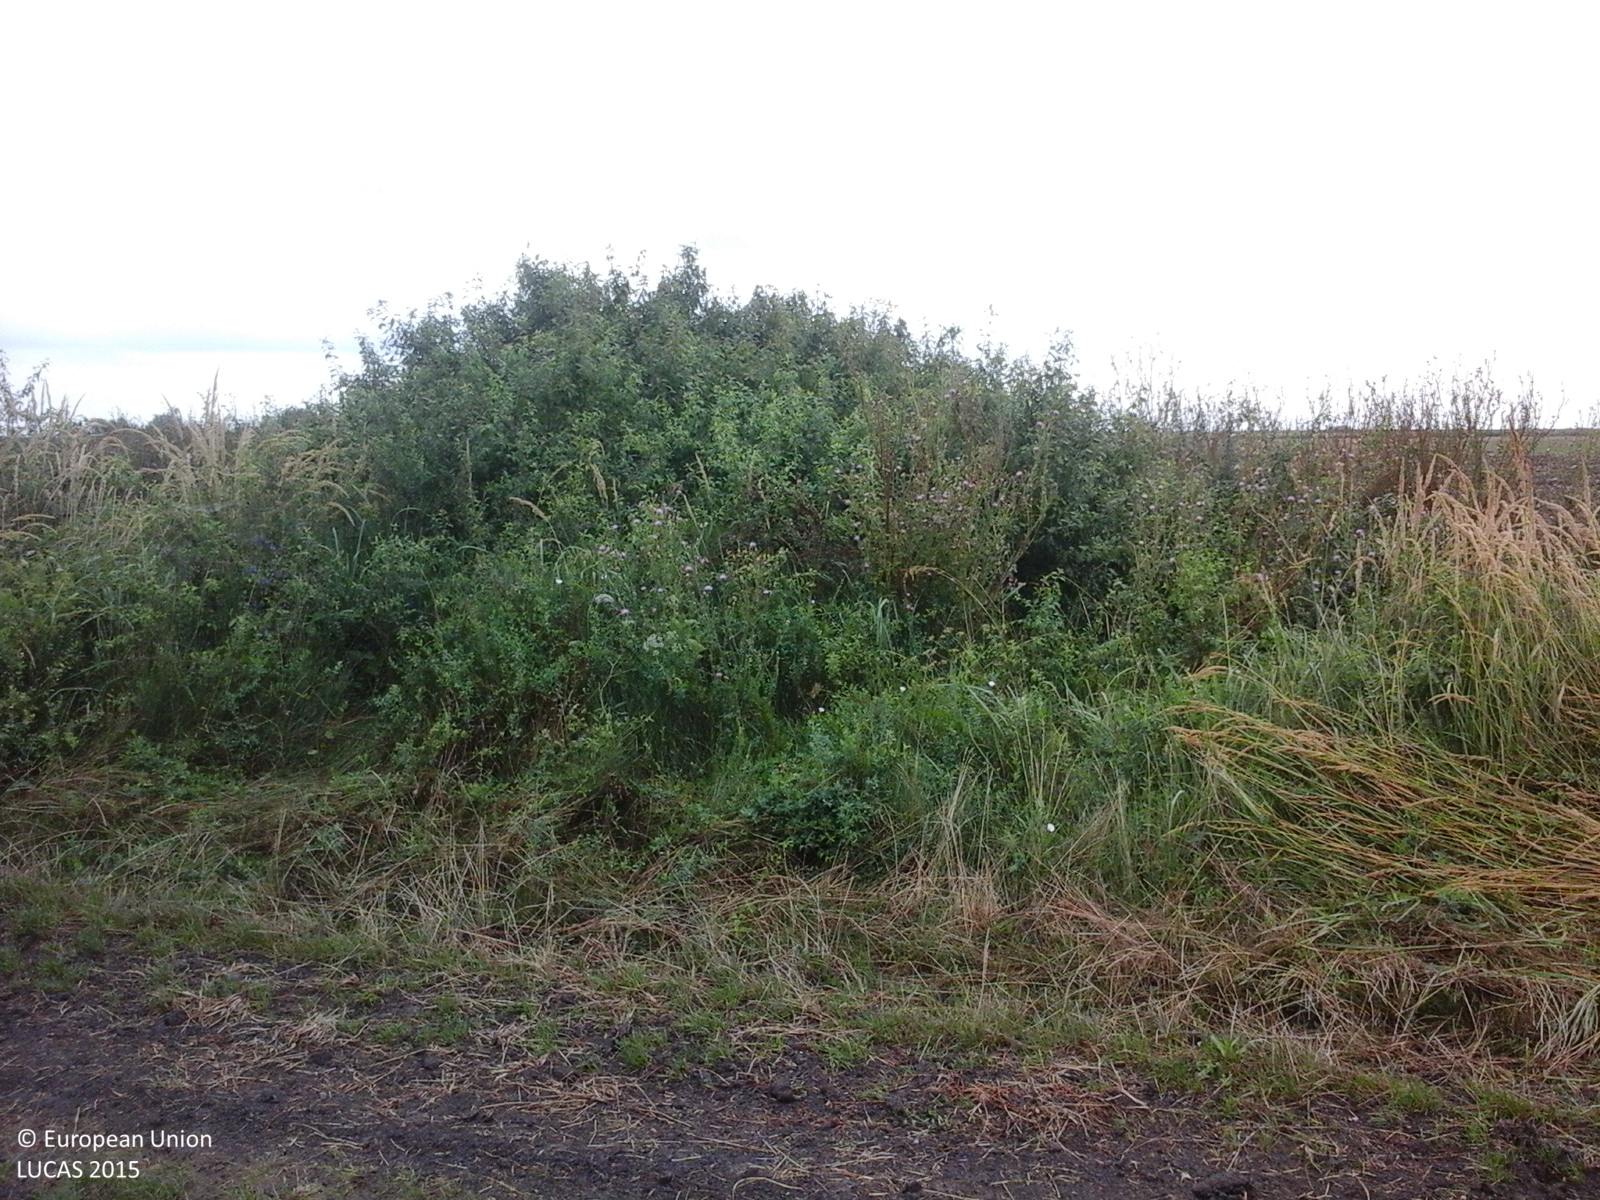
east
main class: Cropland
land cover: Sunflower
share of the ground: > 75 %
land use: Agriculture (excluding fallow land and kitchen gardens)
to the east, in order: Sunflower; Grass margins; Ditches and canals; Grass margins; Sunflower
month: August
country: RO
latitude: 46.0859
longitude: 20.5129
